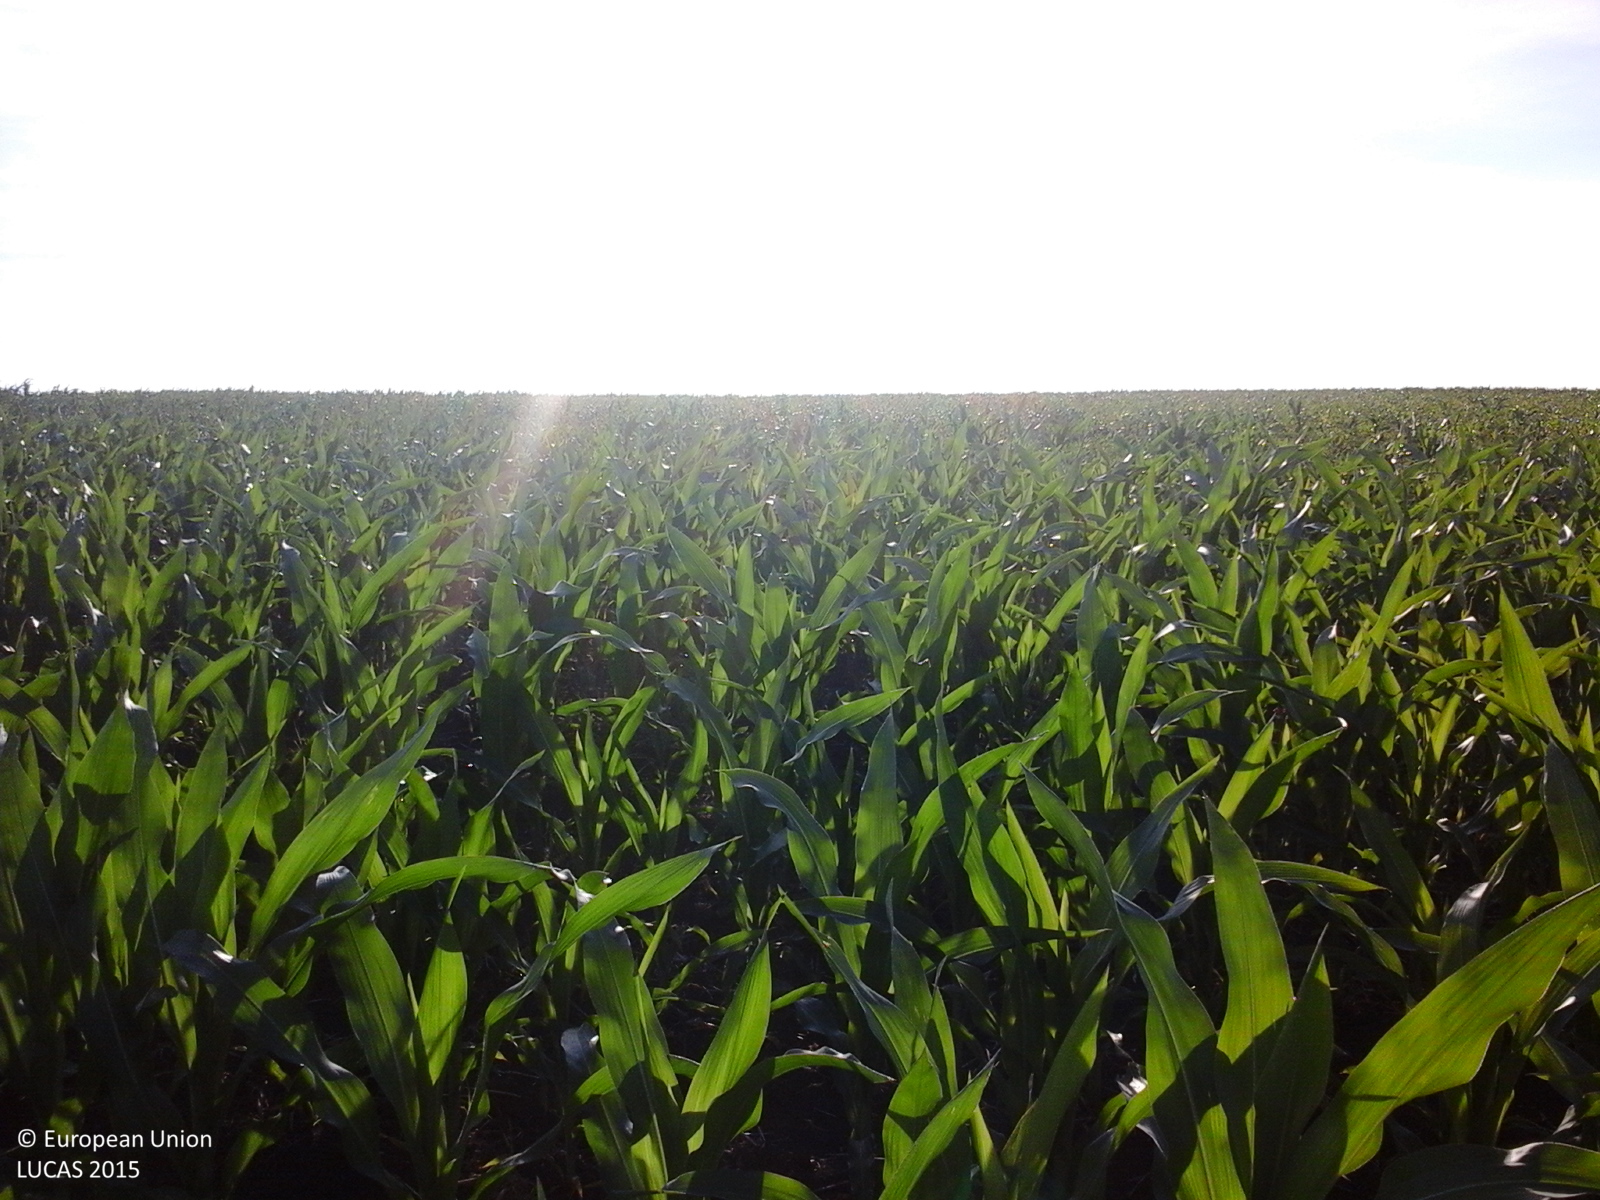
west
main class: Cropland
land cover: Maize
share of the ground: > 75 %
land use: Agriculture (excluding fallow land and kitchen gardens)
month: June
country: RO
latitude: 47.3405
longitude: 27.0582
